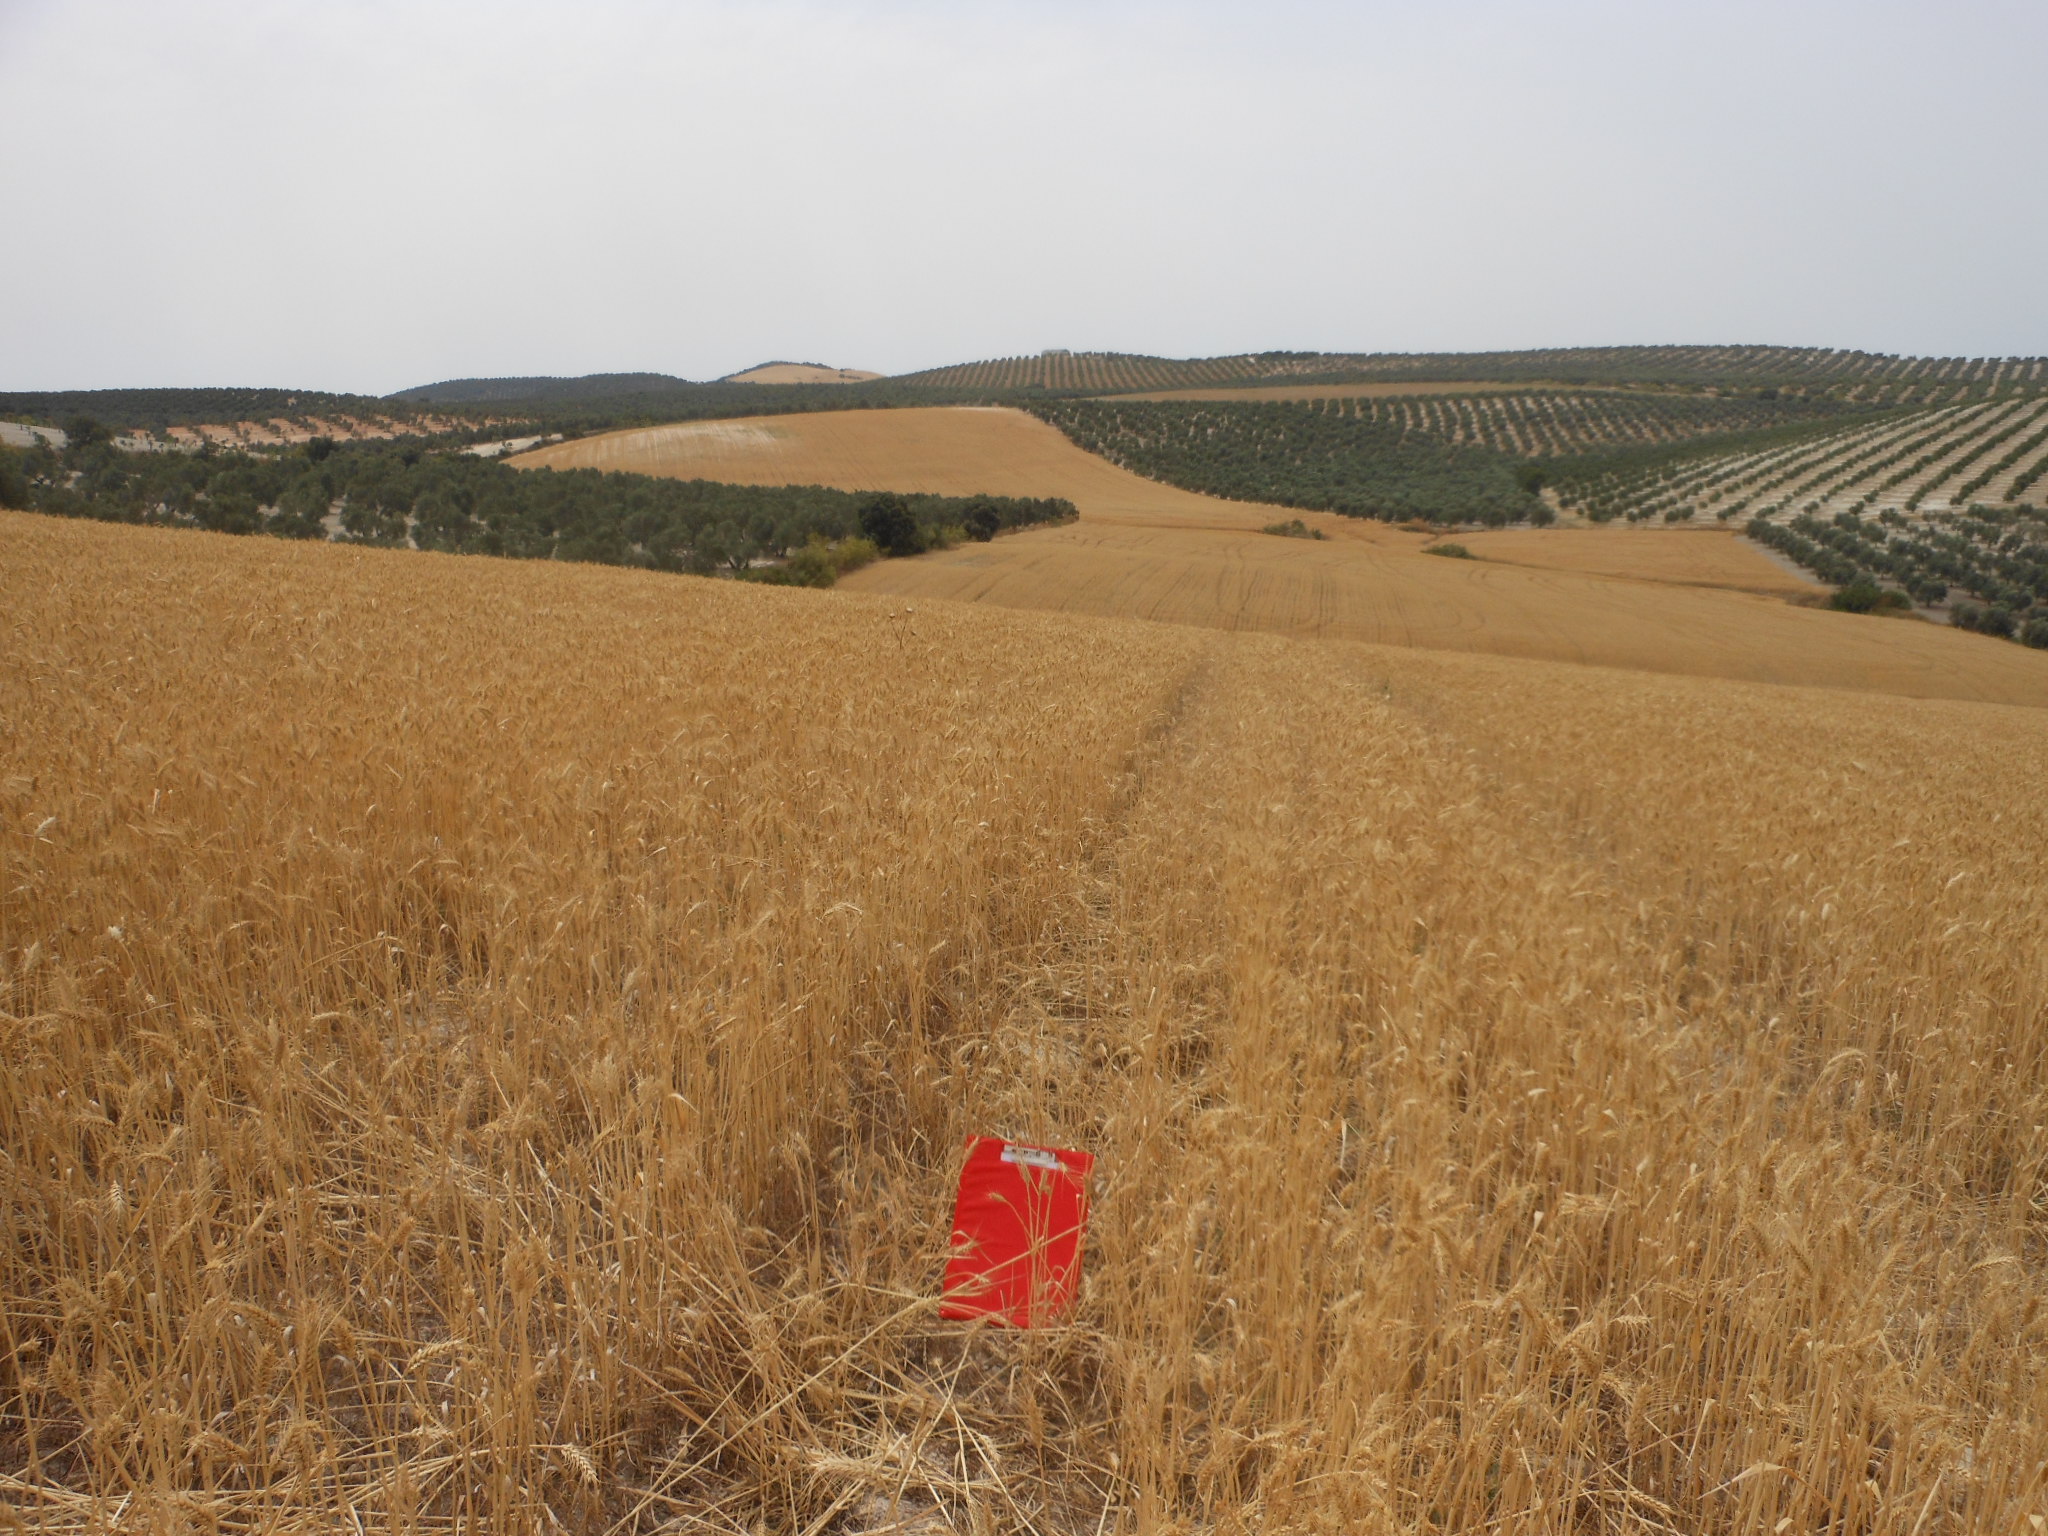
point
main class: Cropland
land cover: Common wheat
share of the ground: > 75 %
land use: Agriculture (excluding fallow land and kitchen gardens)
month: June
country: ES
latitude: 37.2267
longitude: -5.0300
